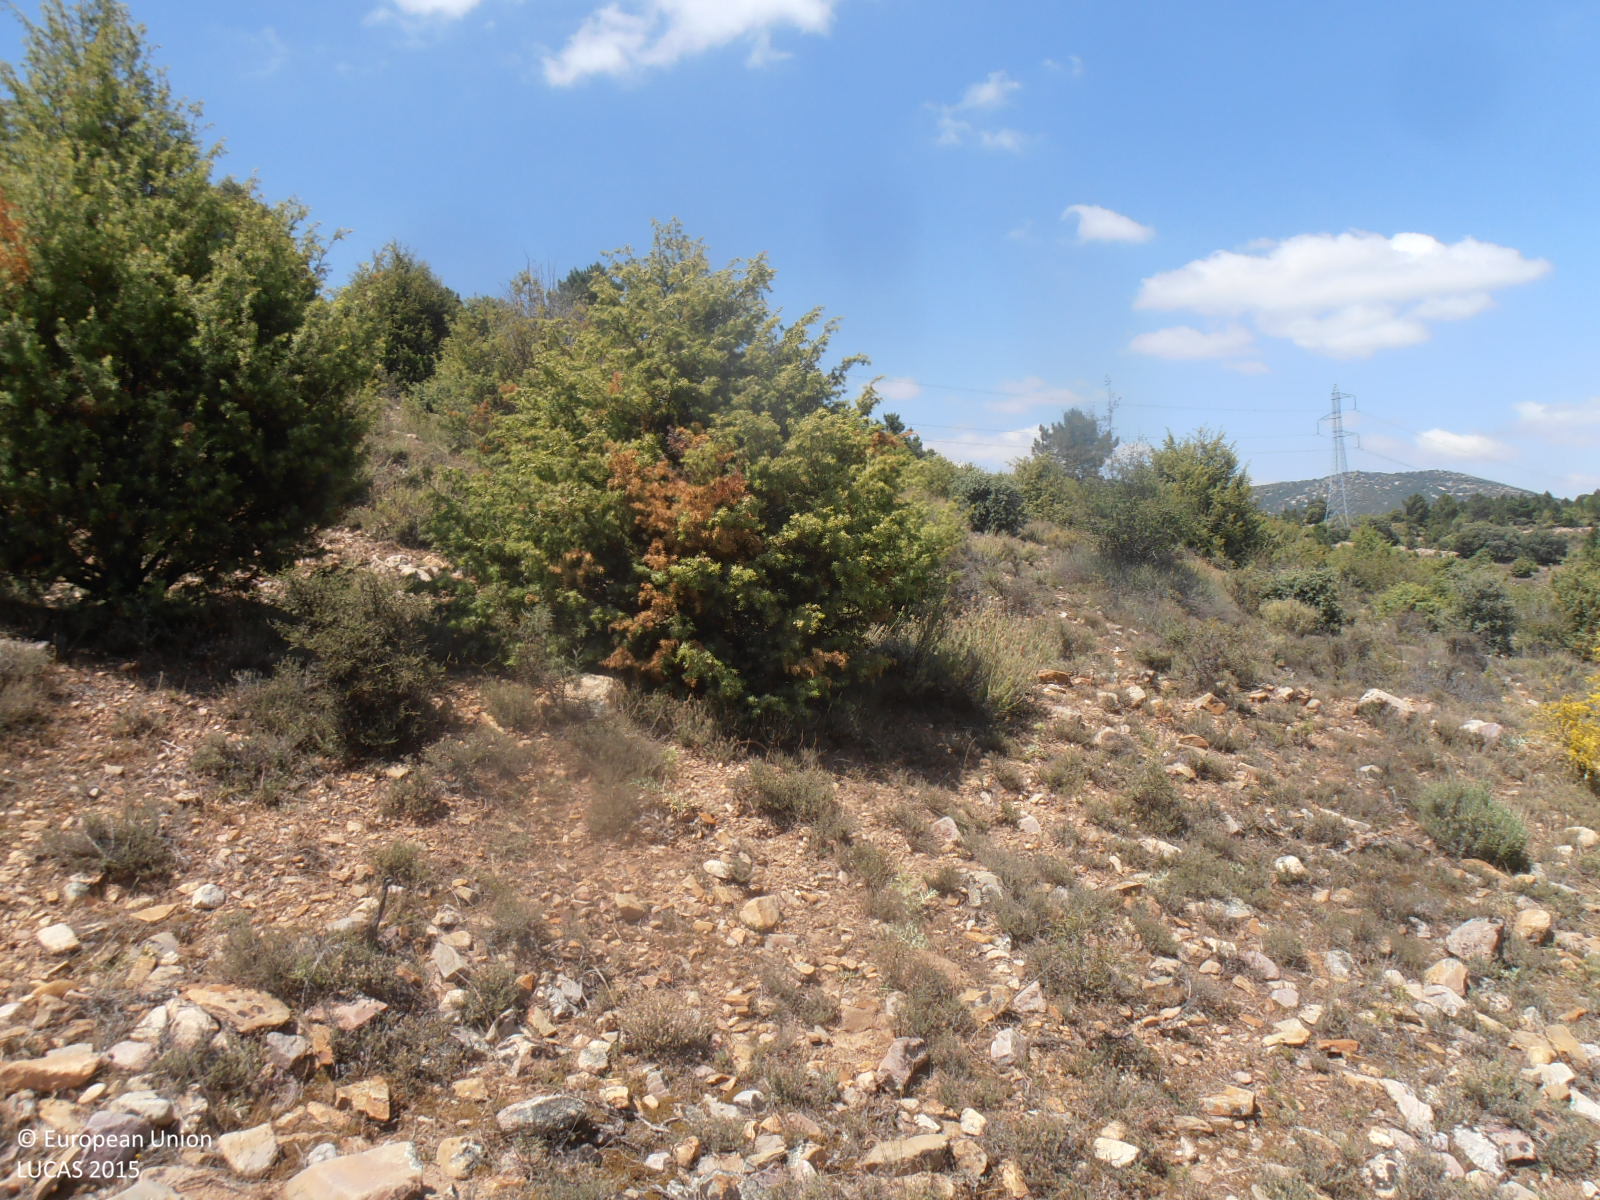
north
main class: Shrubland
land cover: Shrubland with sparse tree cover
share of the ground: 50 - 75 %
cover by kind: shrubs 60 %, consolidated bare surface 20 %, herbaceous plants 15 %, coniferous forest trees 5 %
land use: Semi-natural and natural areas not in use
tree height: < 5 m
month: June
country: ES
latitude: 41.2791
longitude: -1.4003
